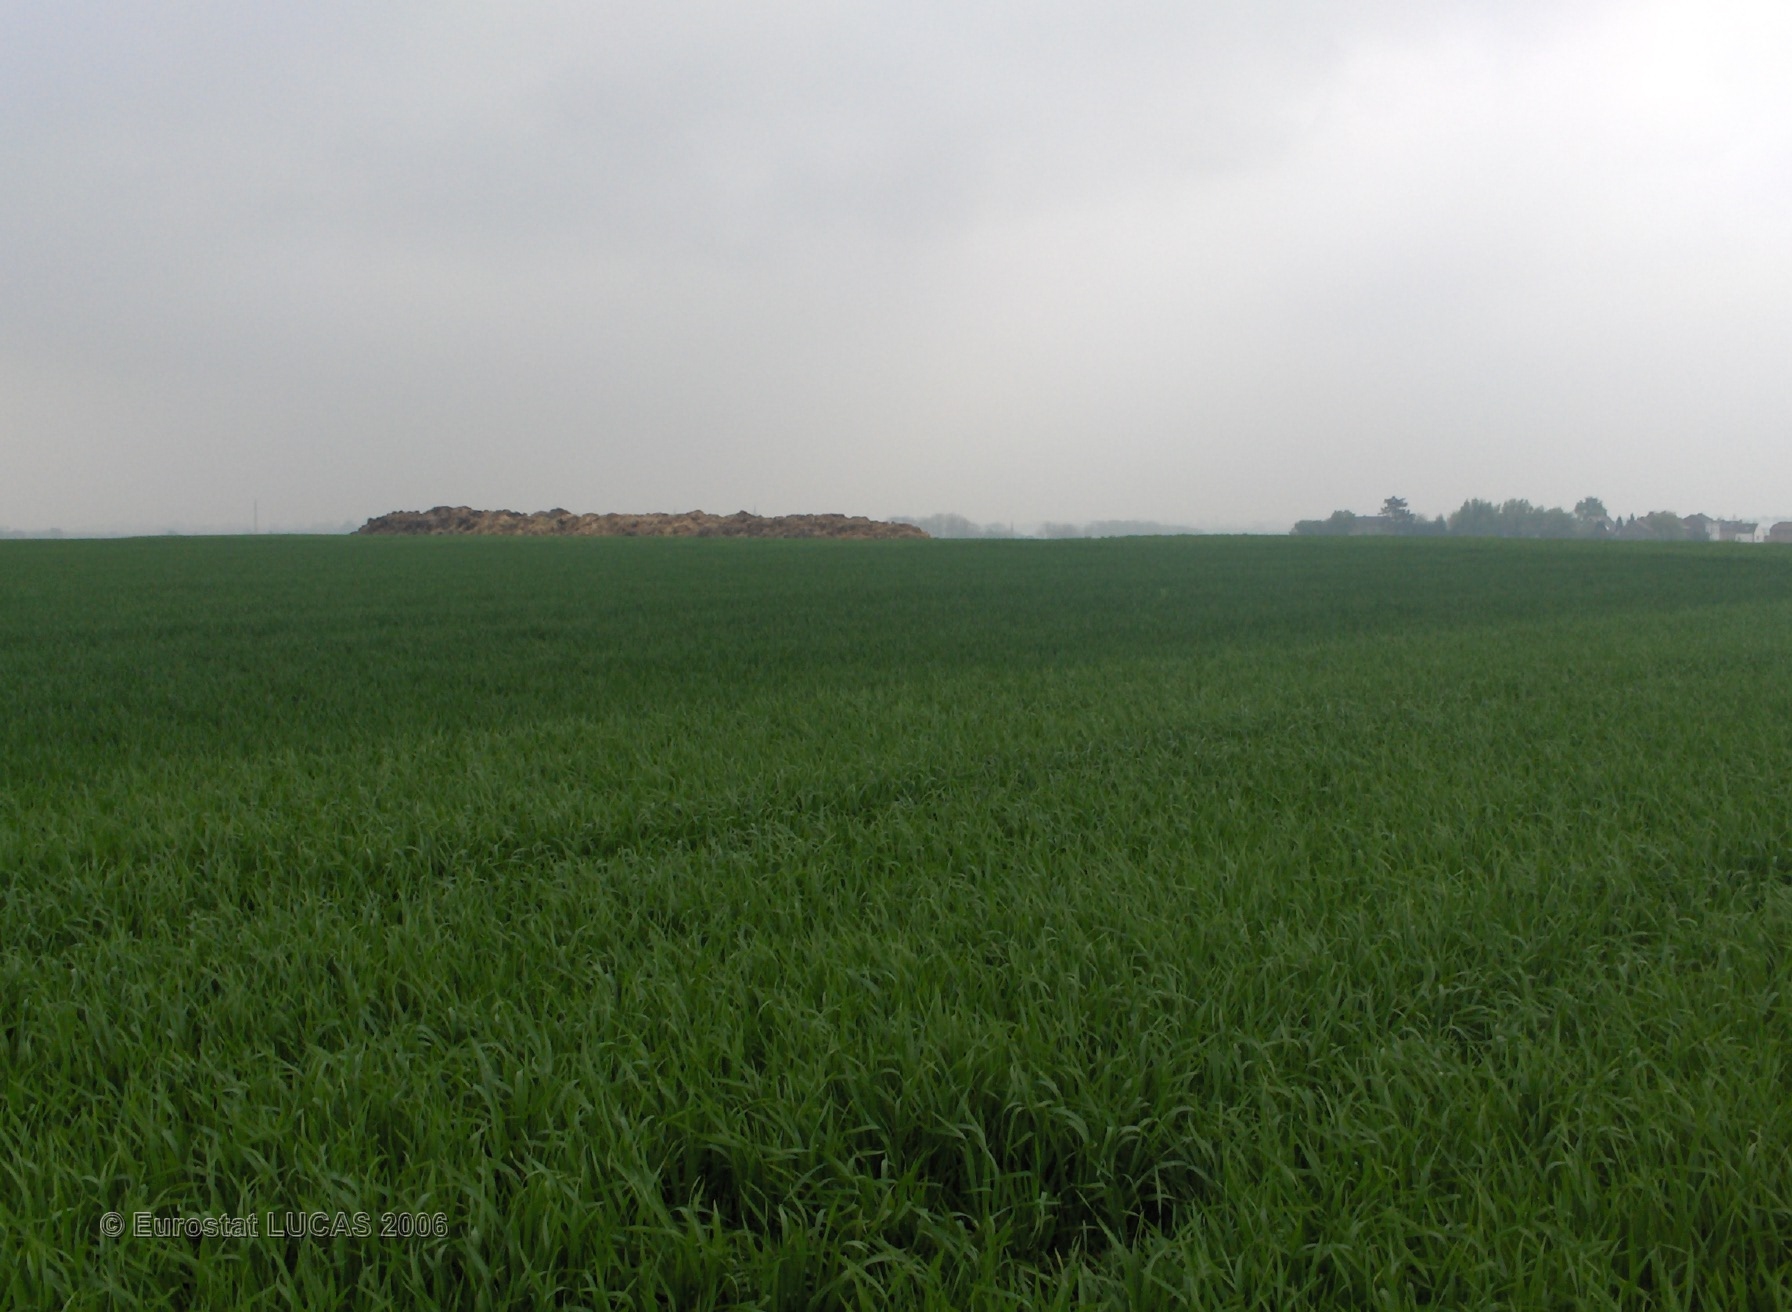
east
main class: Cropland
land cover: Common wheat
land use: Agriculture (excluding fallow land and kitchen gardens)
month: May
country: BE
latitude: 50.5233
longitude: 4.5655
